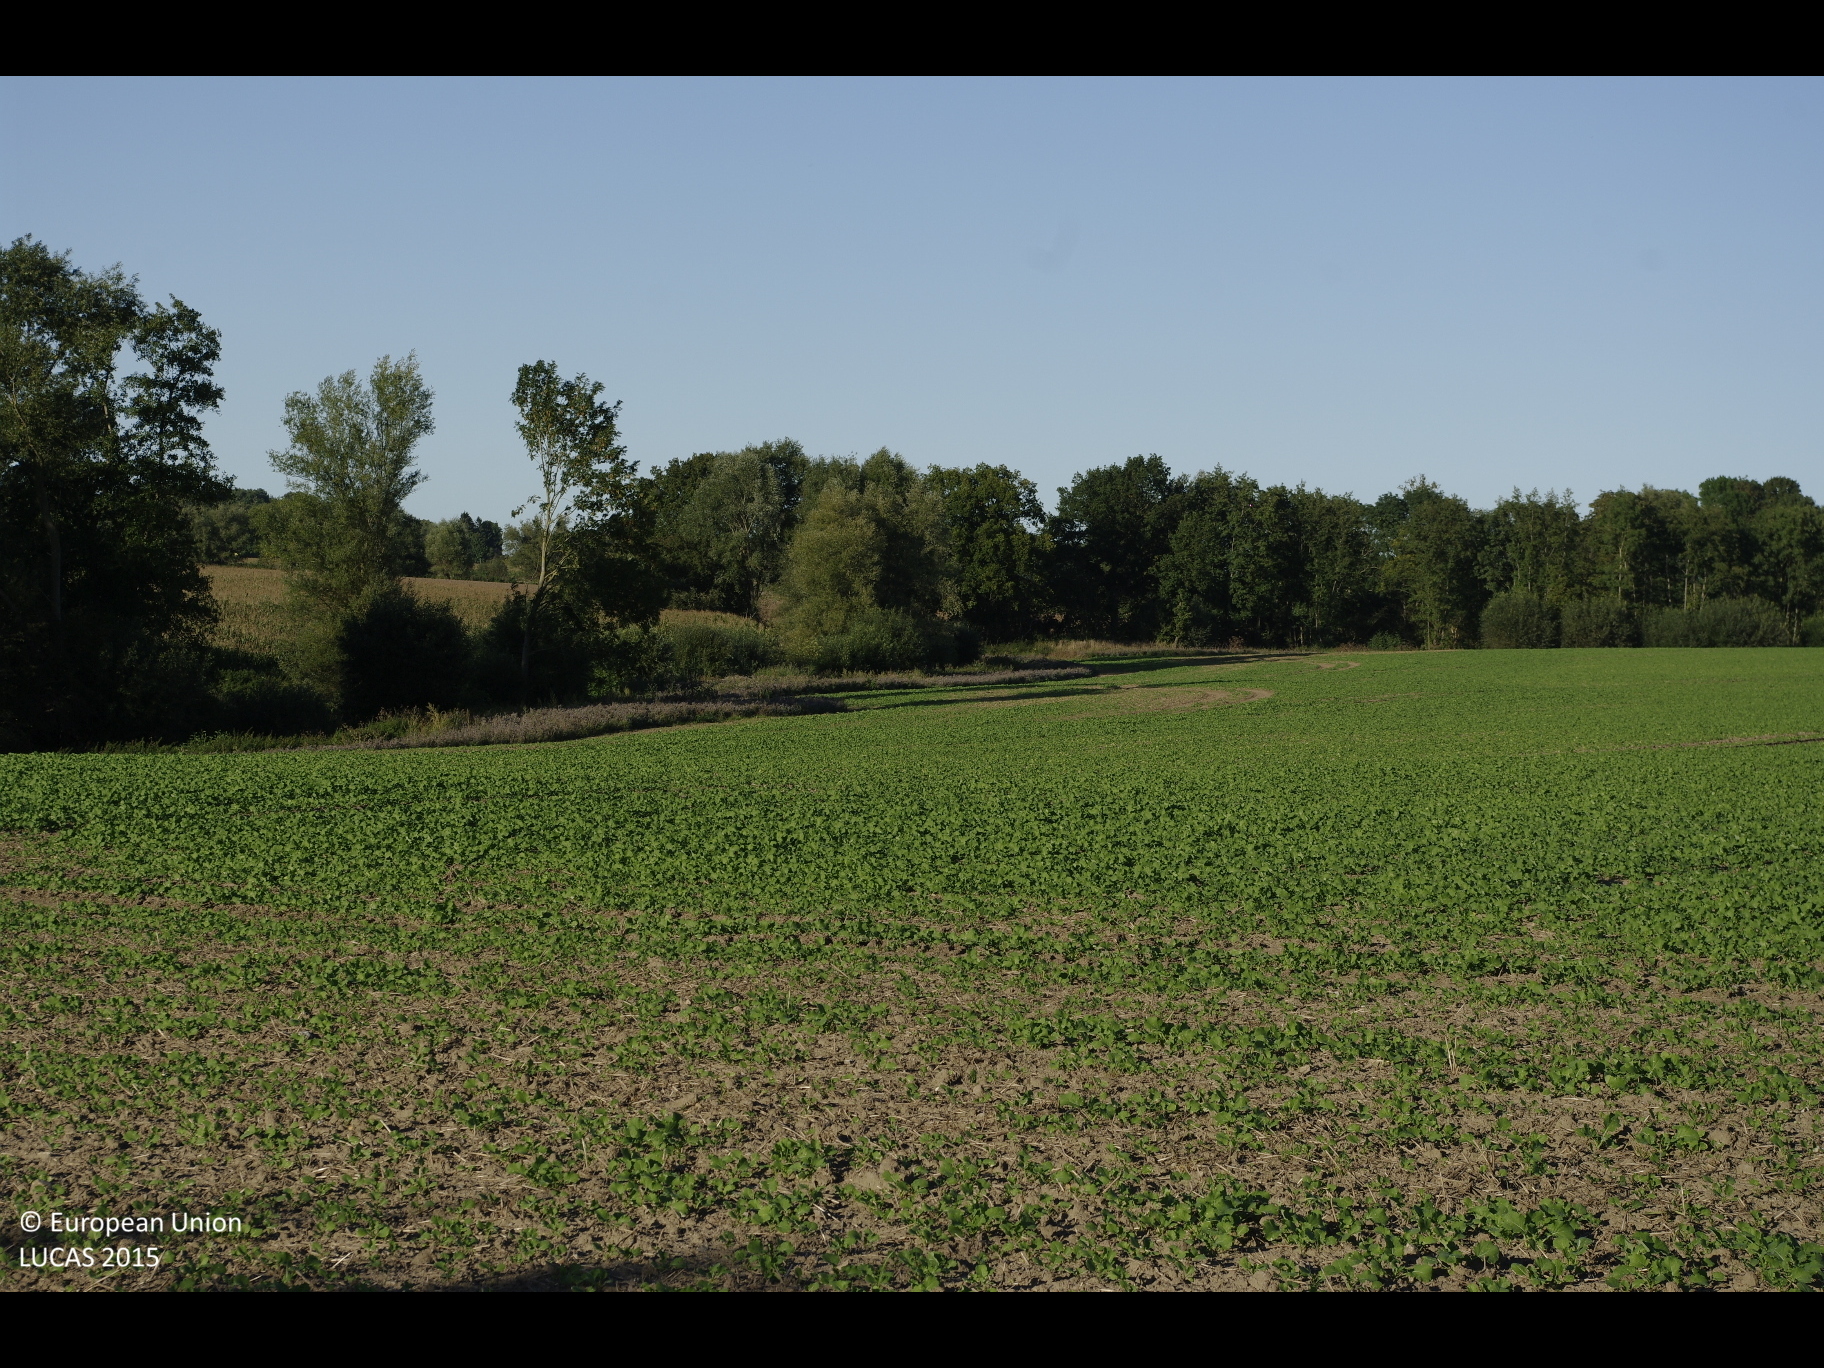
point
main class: Cropland
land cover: Rape and turnip rape
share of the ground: 50 - 75 %
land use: Agriculture (excluding fallow land and kitchen gardens)
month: September
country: DE
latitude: 53.9191
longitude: 10.9892
